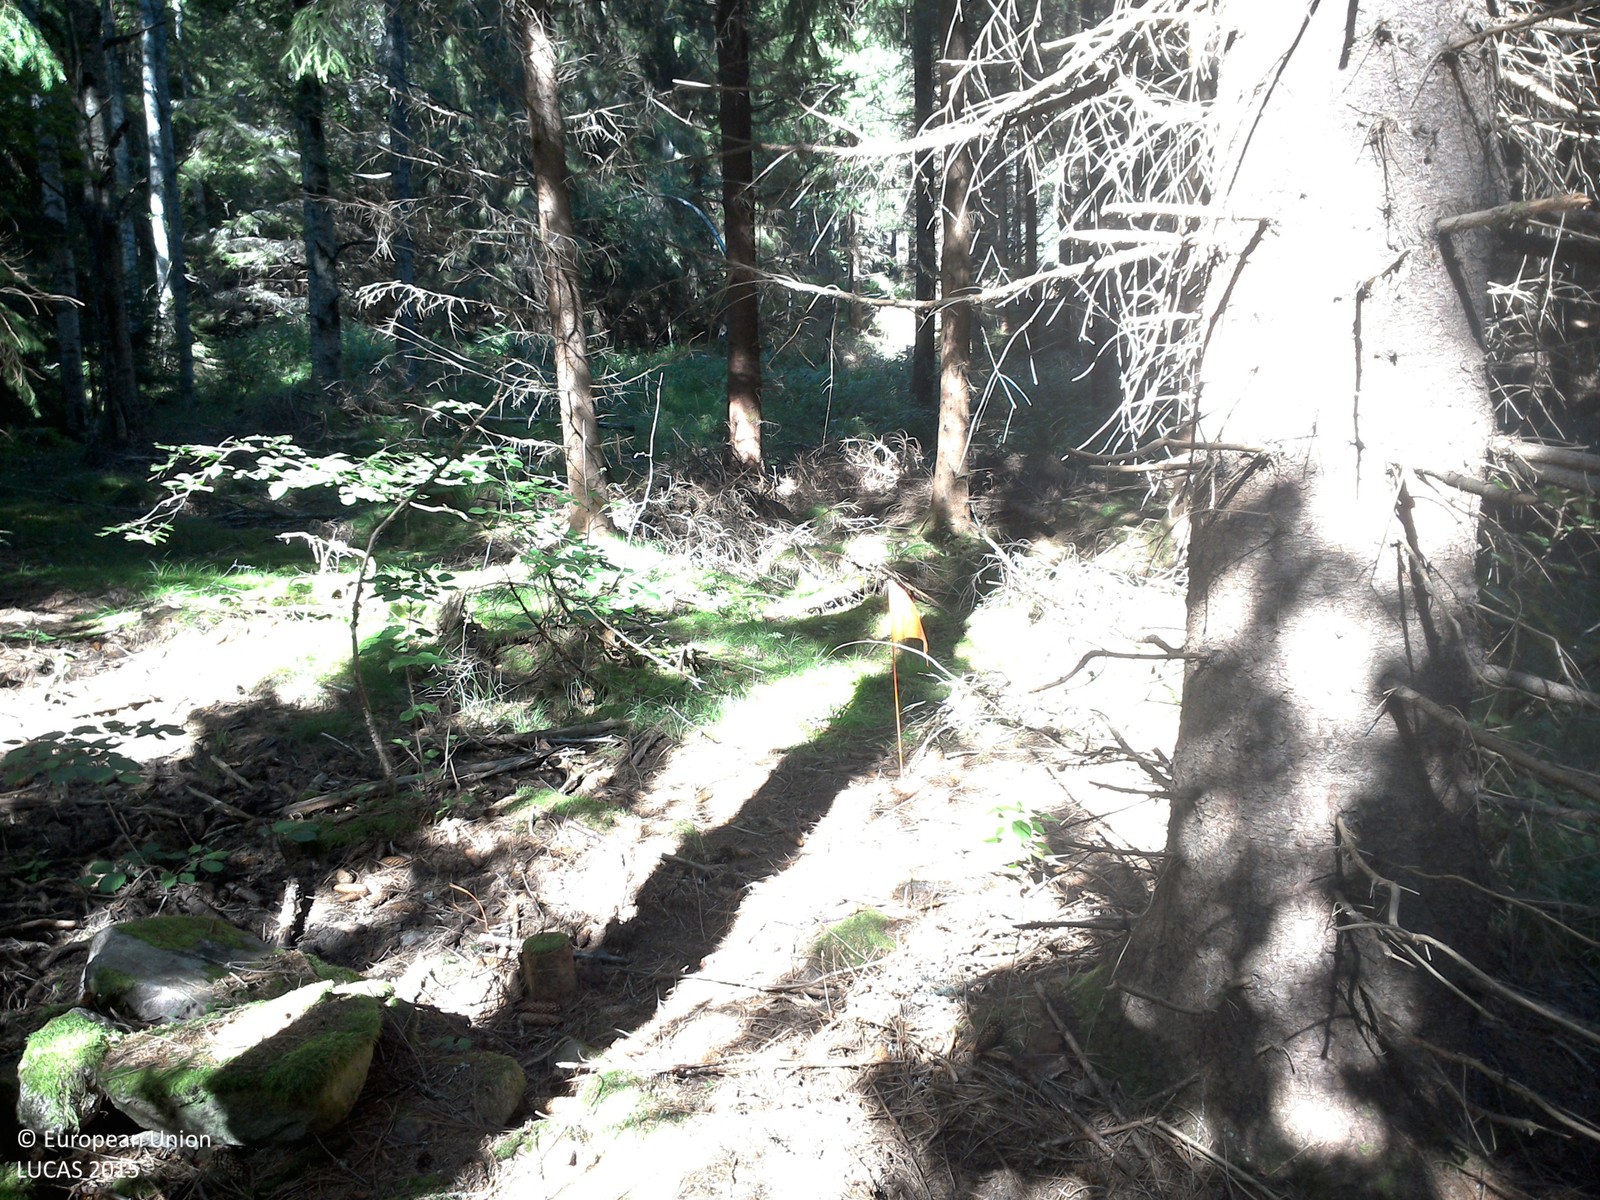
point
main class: Woodland
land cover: Spruce dominated coniferous woodland
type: boreal forest
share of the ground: > 75 %
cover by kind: coniferous forest trees 85 %, herbaceous plants 5 %, lichens and mosses 5 %, unconsolidated bare surface 5 %
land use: Forestry
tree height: > 5 m
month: August
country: SE
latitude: 57.8915
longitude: 15.4780
